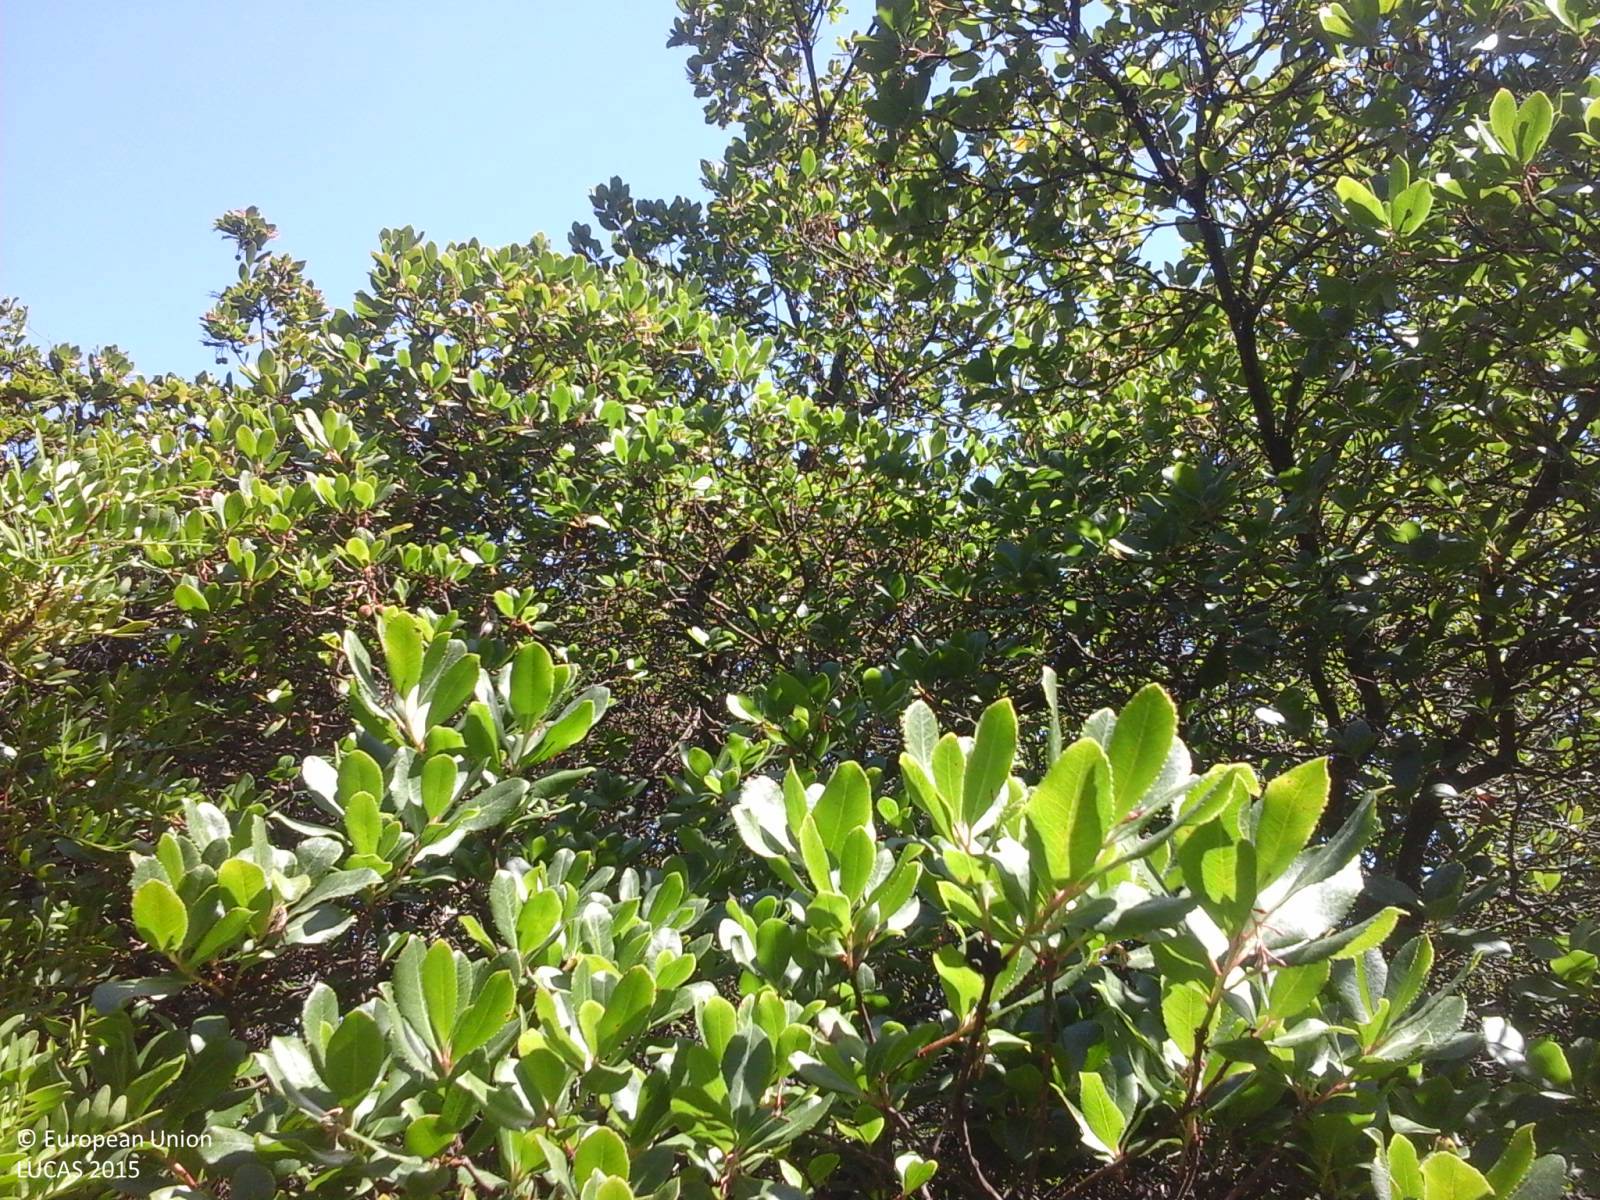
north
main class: Shrubland
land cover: Shrubland without tree cover
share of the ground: > 75 %
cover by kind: shrubs 80 %, herbaceous plants 10 %, unconsolidated bare surface 10 %
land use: Semi-natural and natural areas not in use
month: August
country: IT
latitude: 39.6499
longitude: 9.4091
